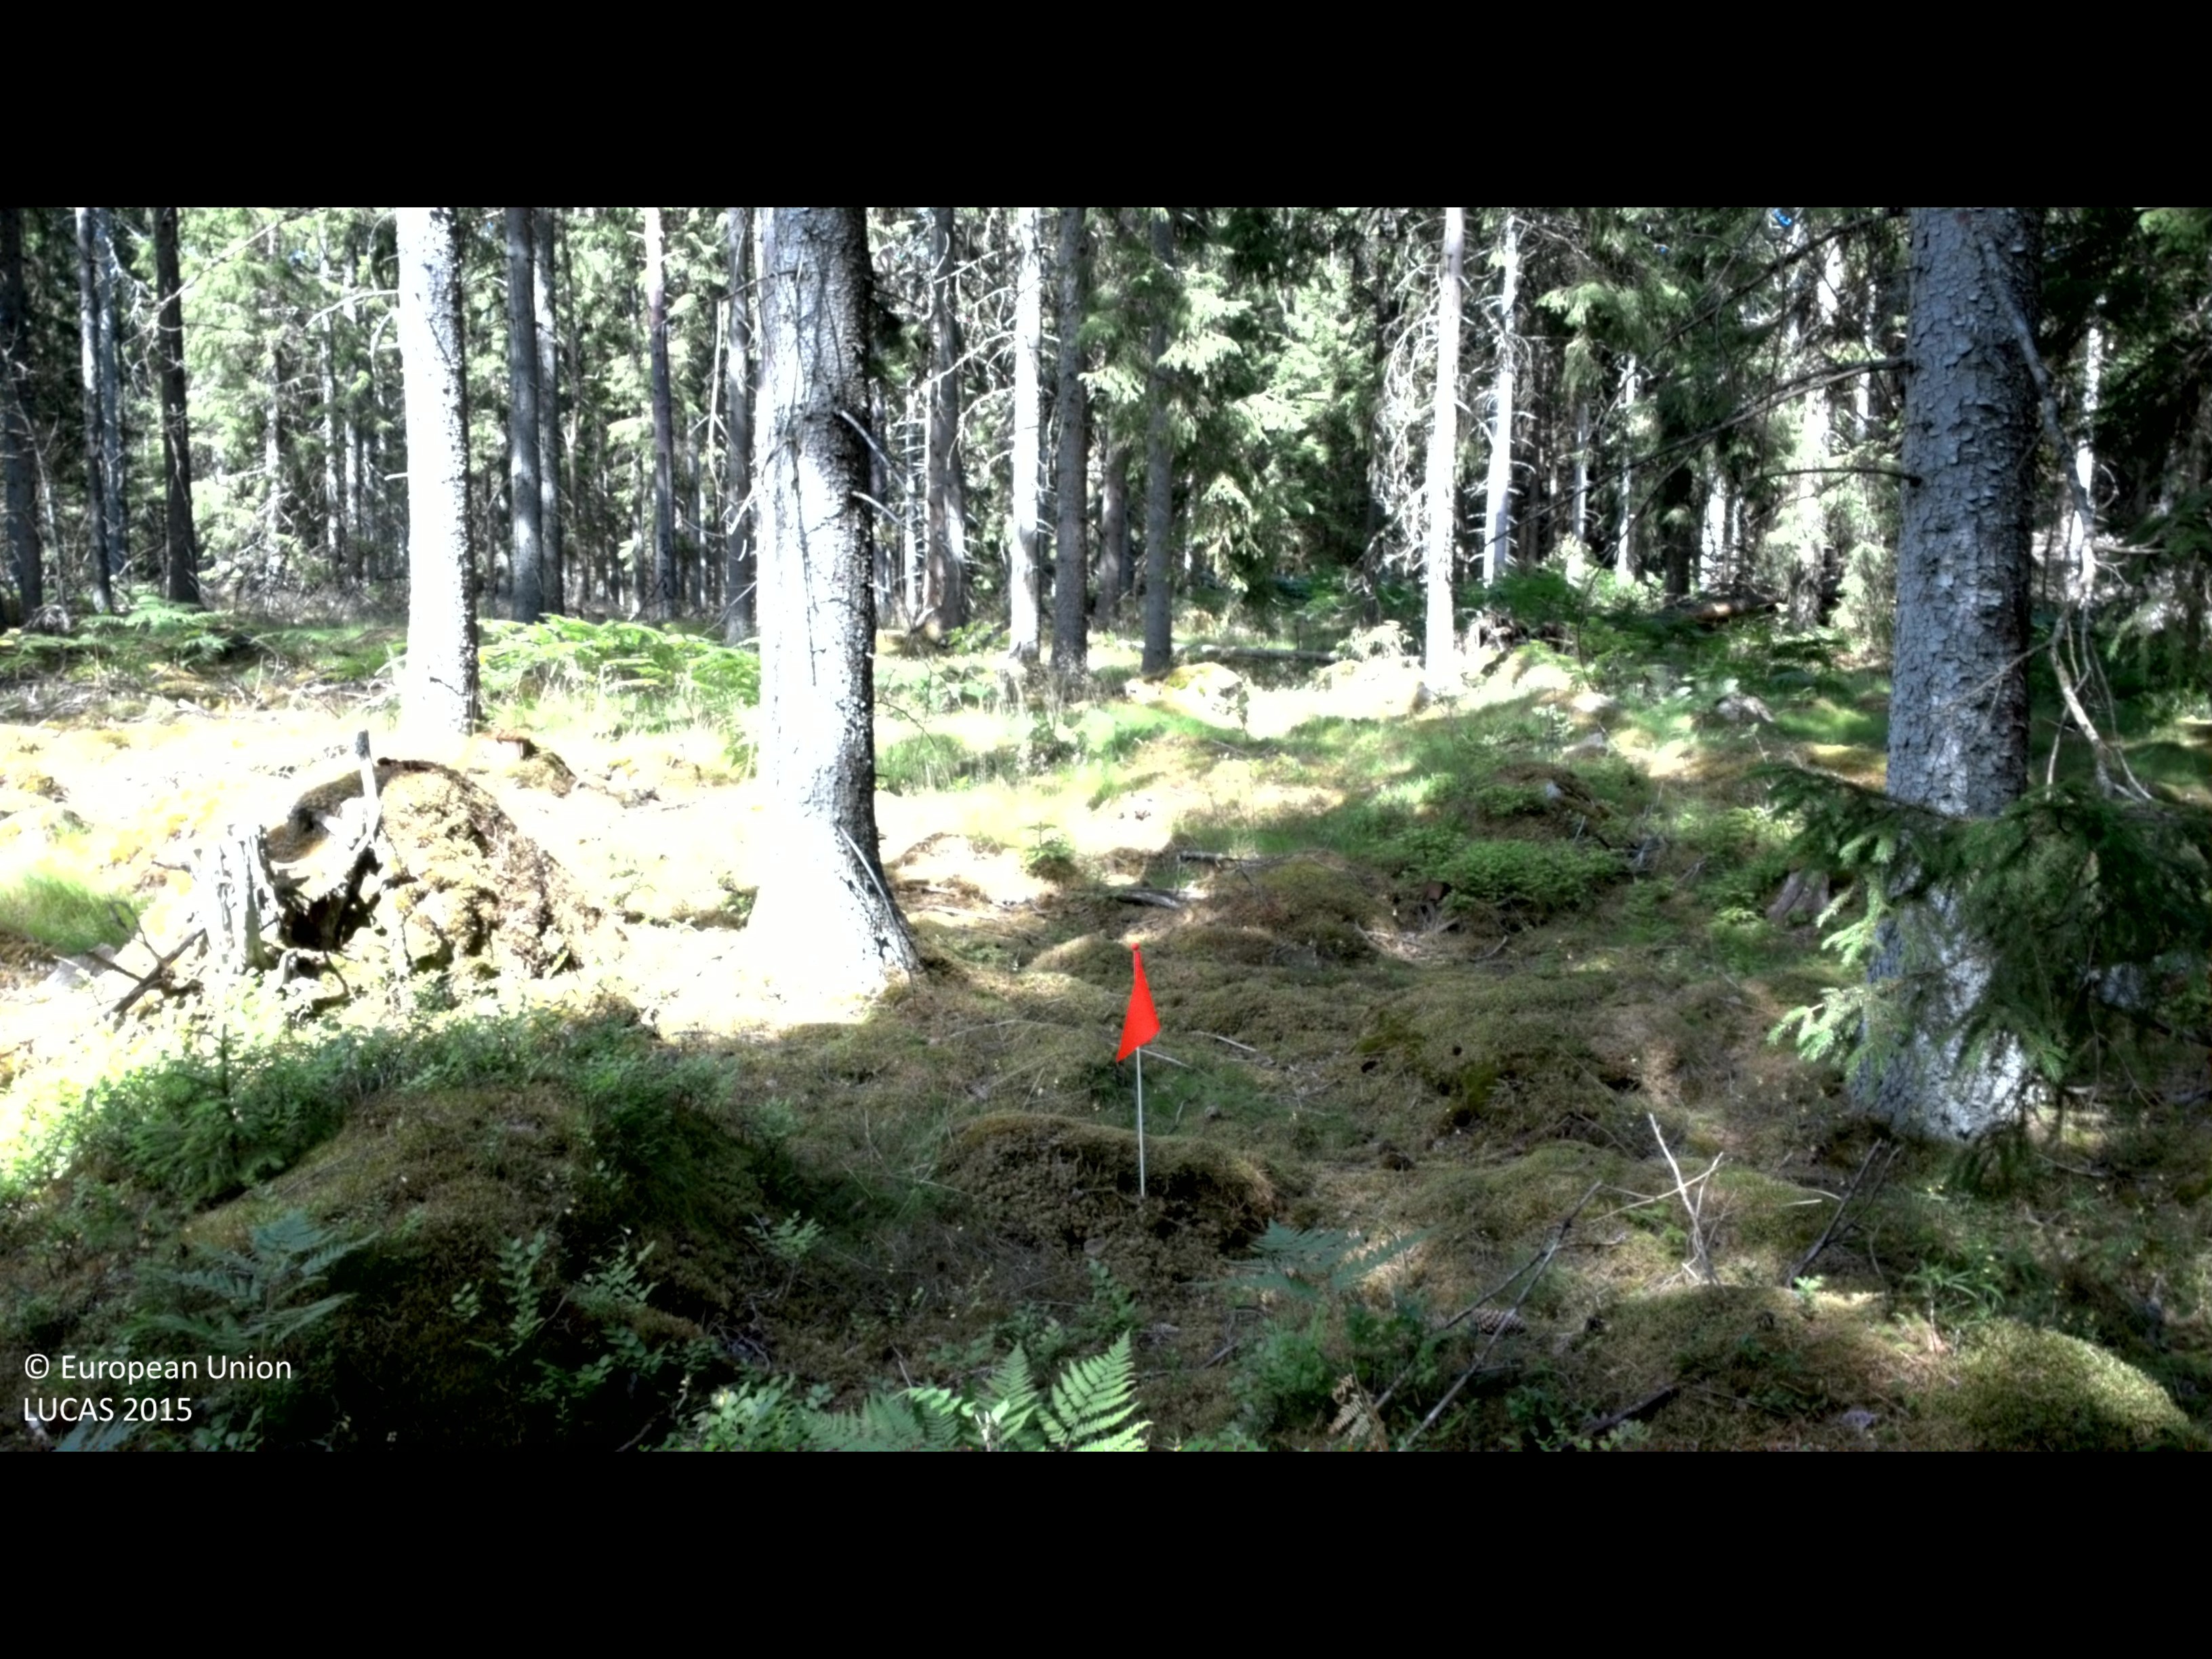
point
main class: Woodland
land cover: Spruce dominated coniferous woodland
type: boreal forest
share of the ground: 50 - 75 %
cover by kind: coniferous forest trees 60 %, lichens and mosses 20 %, shrubs 15 %, herbaceous plants 5 %
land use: Forestry
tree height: > 5 m
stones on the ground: 25 - 50 %
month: July
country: SE
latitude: 56.4850
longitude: 14.5607
